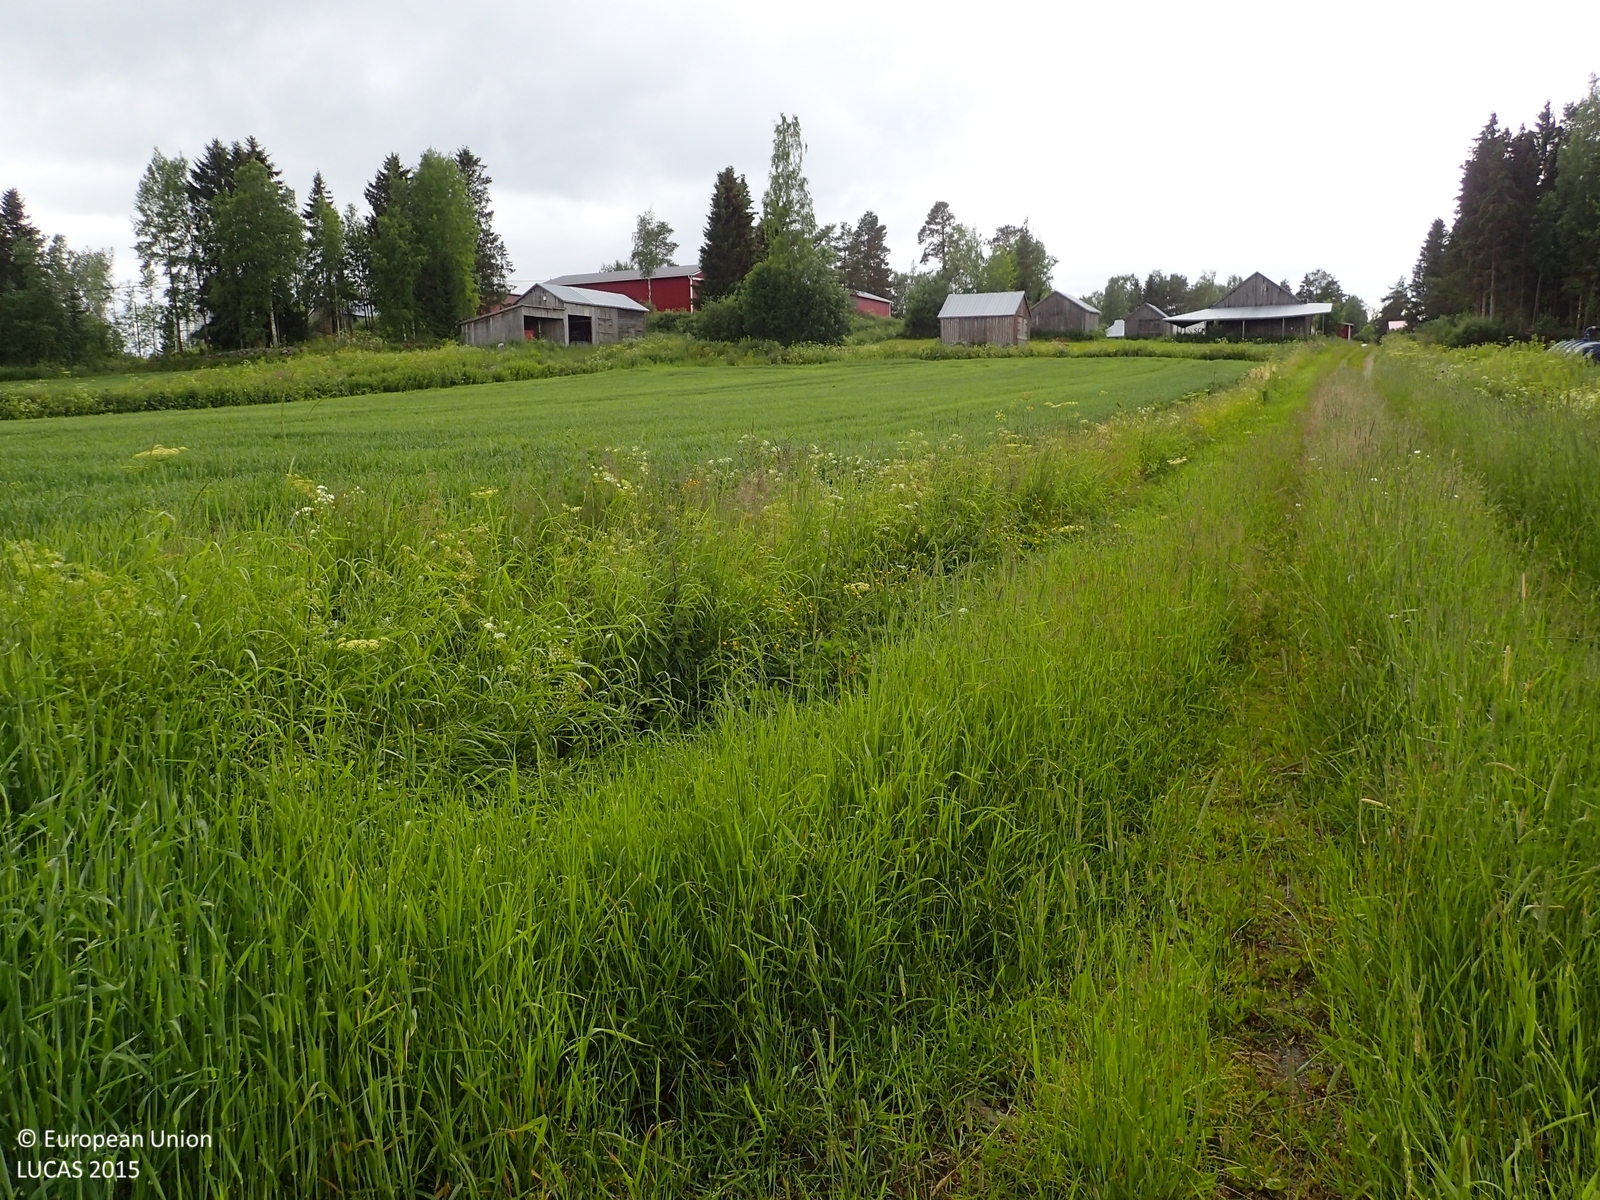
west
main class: Cropland
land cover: Arable land (only in case pi)
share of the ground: > 75 %
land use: Agriculture (excluding fallow land and kitchen gardens)
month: July
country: FI
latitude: 62.9234
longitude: 21.6801
